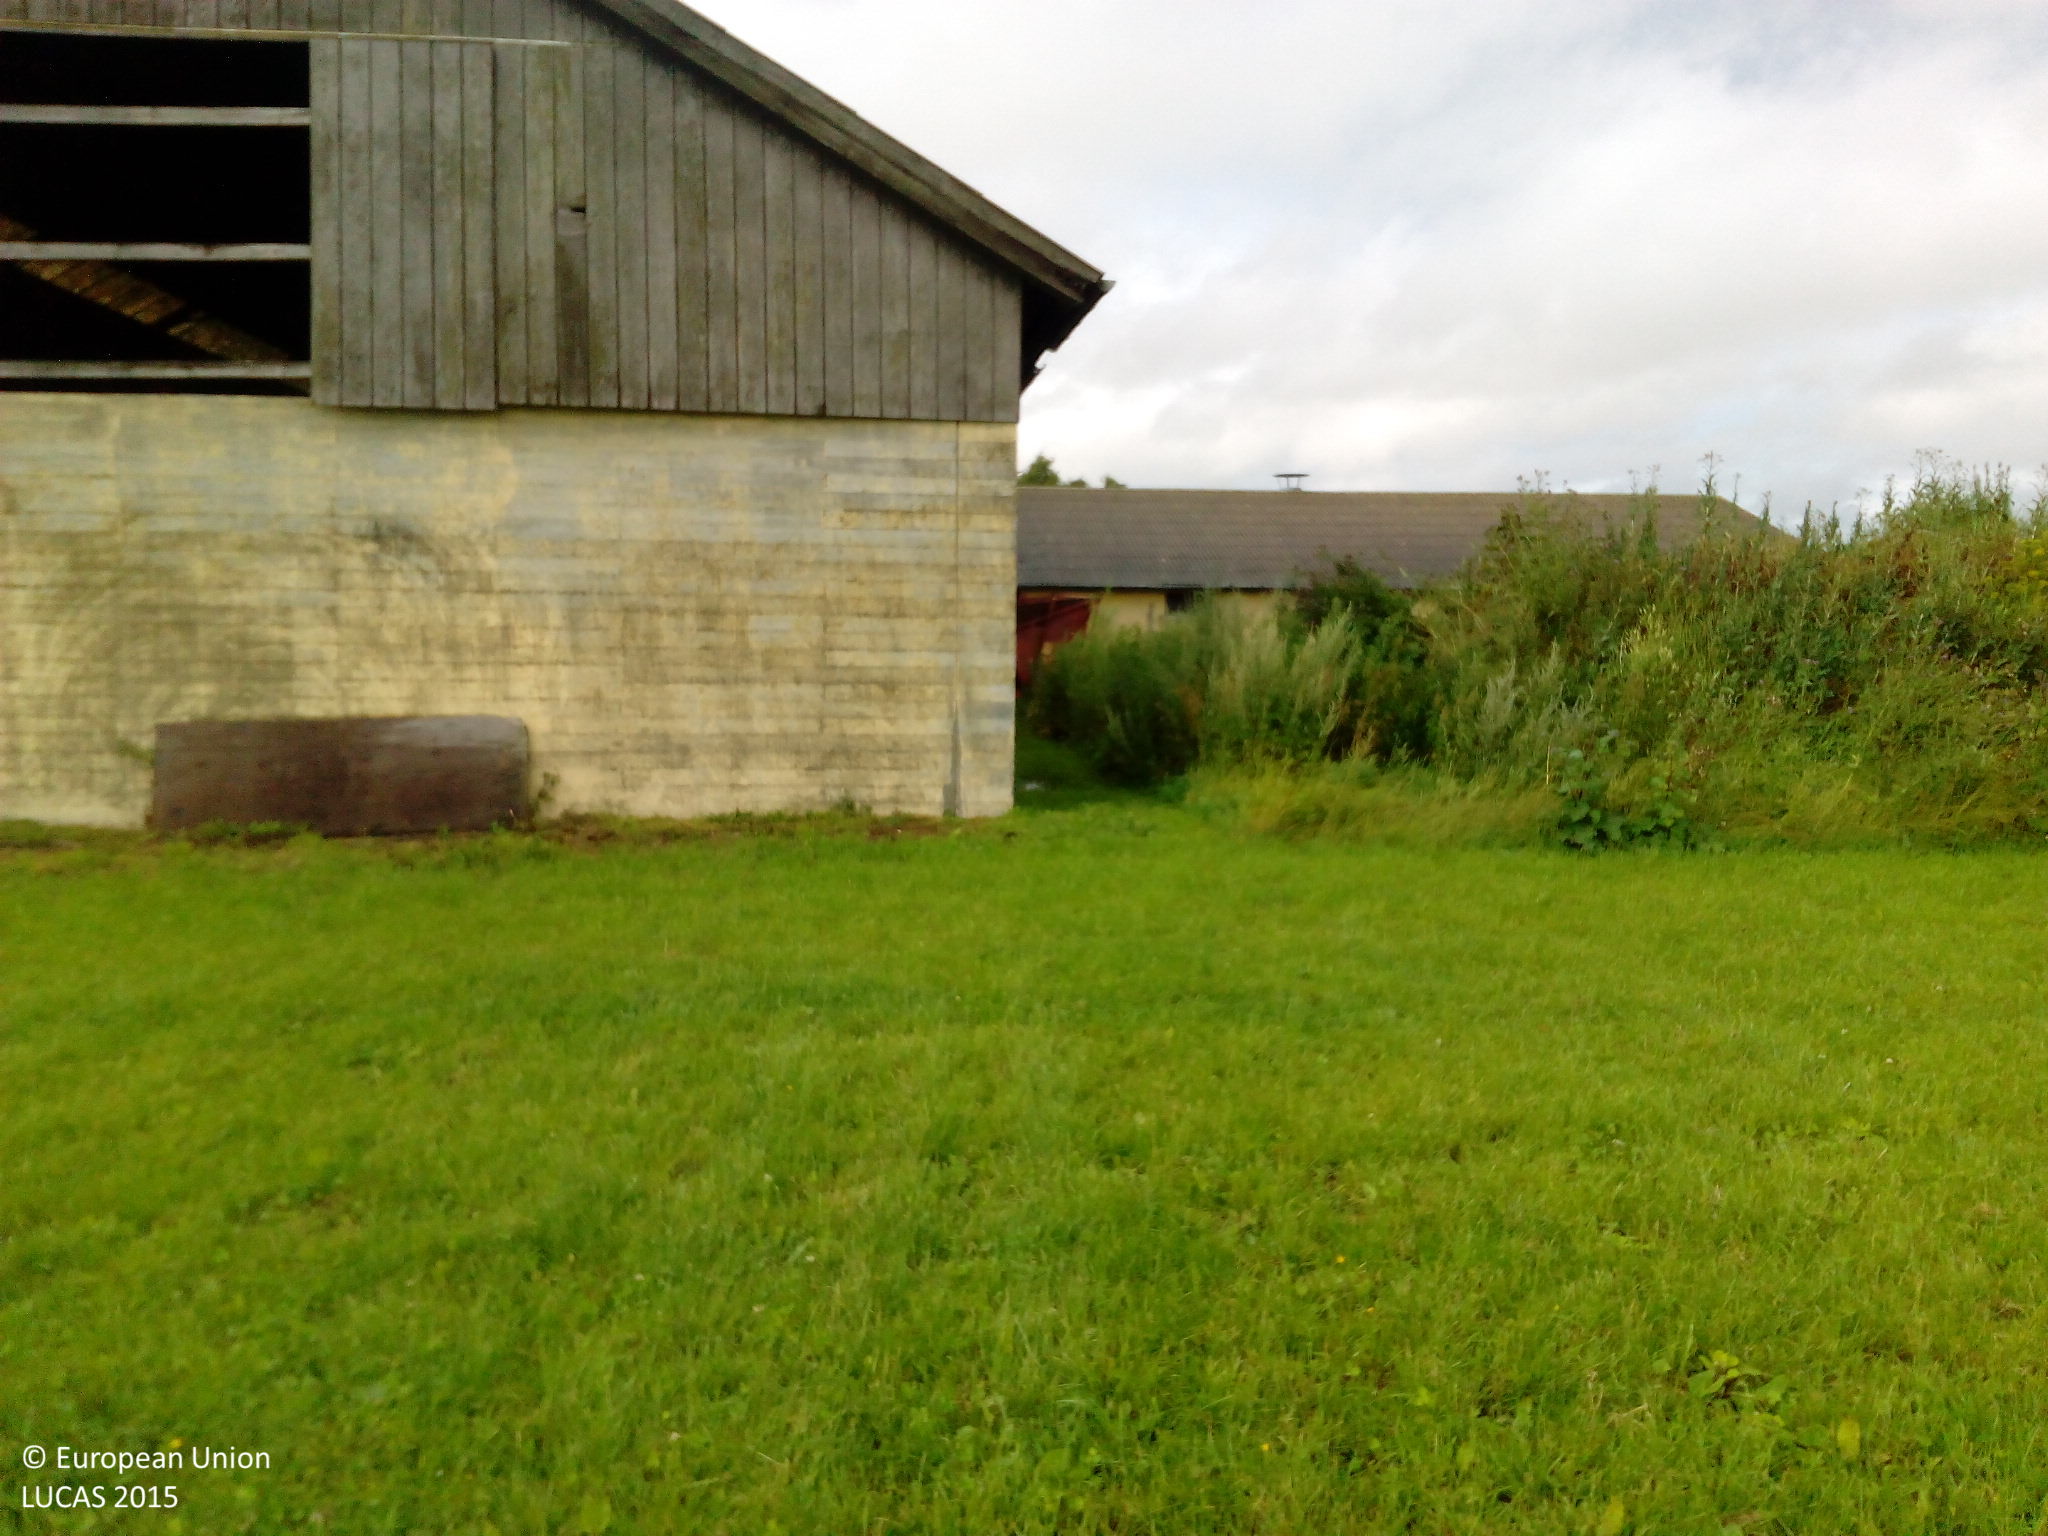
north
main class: Grassland
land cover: Grassland without tree/shrub cover
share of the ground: > 75 %
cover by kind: herbaceous plants 100 %
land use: Agriculture (excluding fallow land and kitchen gardens)
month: July
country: DK
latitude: 55.8994
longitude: 12.1890
